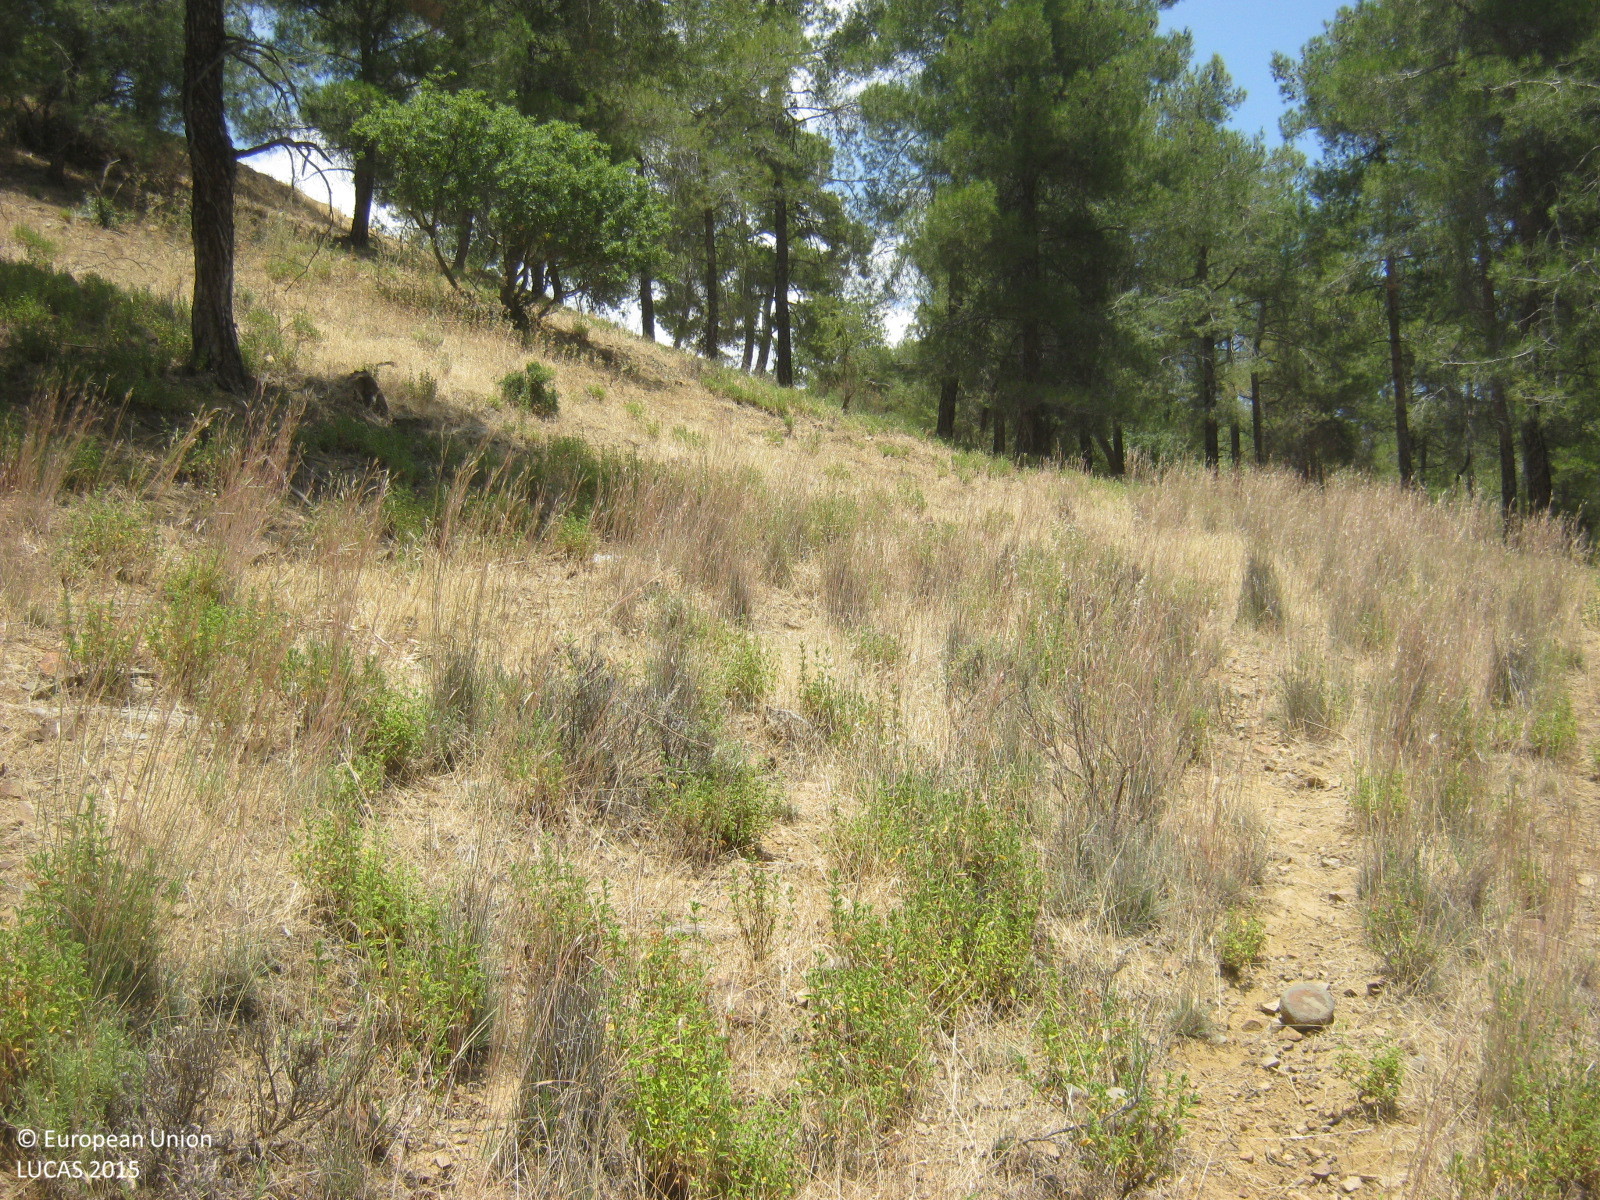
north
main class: Woodland
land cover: Pine dominated coniferous woodland
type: coniferous forest of the mediterranean region
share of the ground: 50 - 75 %
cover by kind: coniferous forest trees 70 %, shrubs 15 %, herbaceous plants 10 %, unconsolidated bare surface 5 %
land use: Forestry
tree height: > 5 m
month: June
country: CY
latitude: 34.9643
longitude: 33.2131
